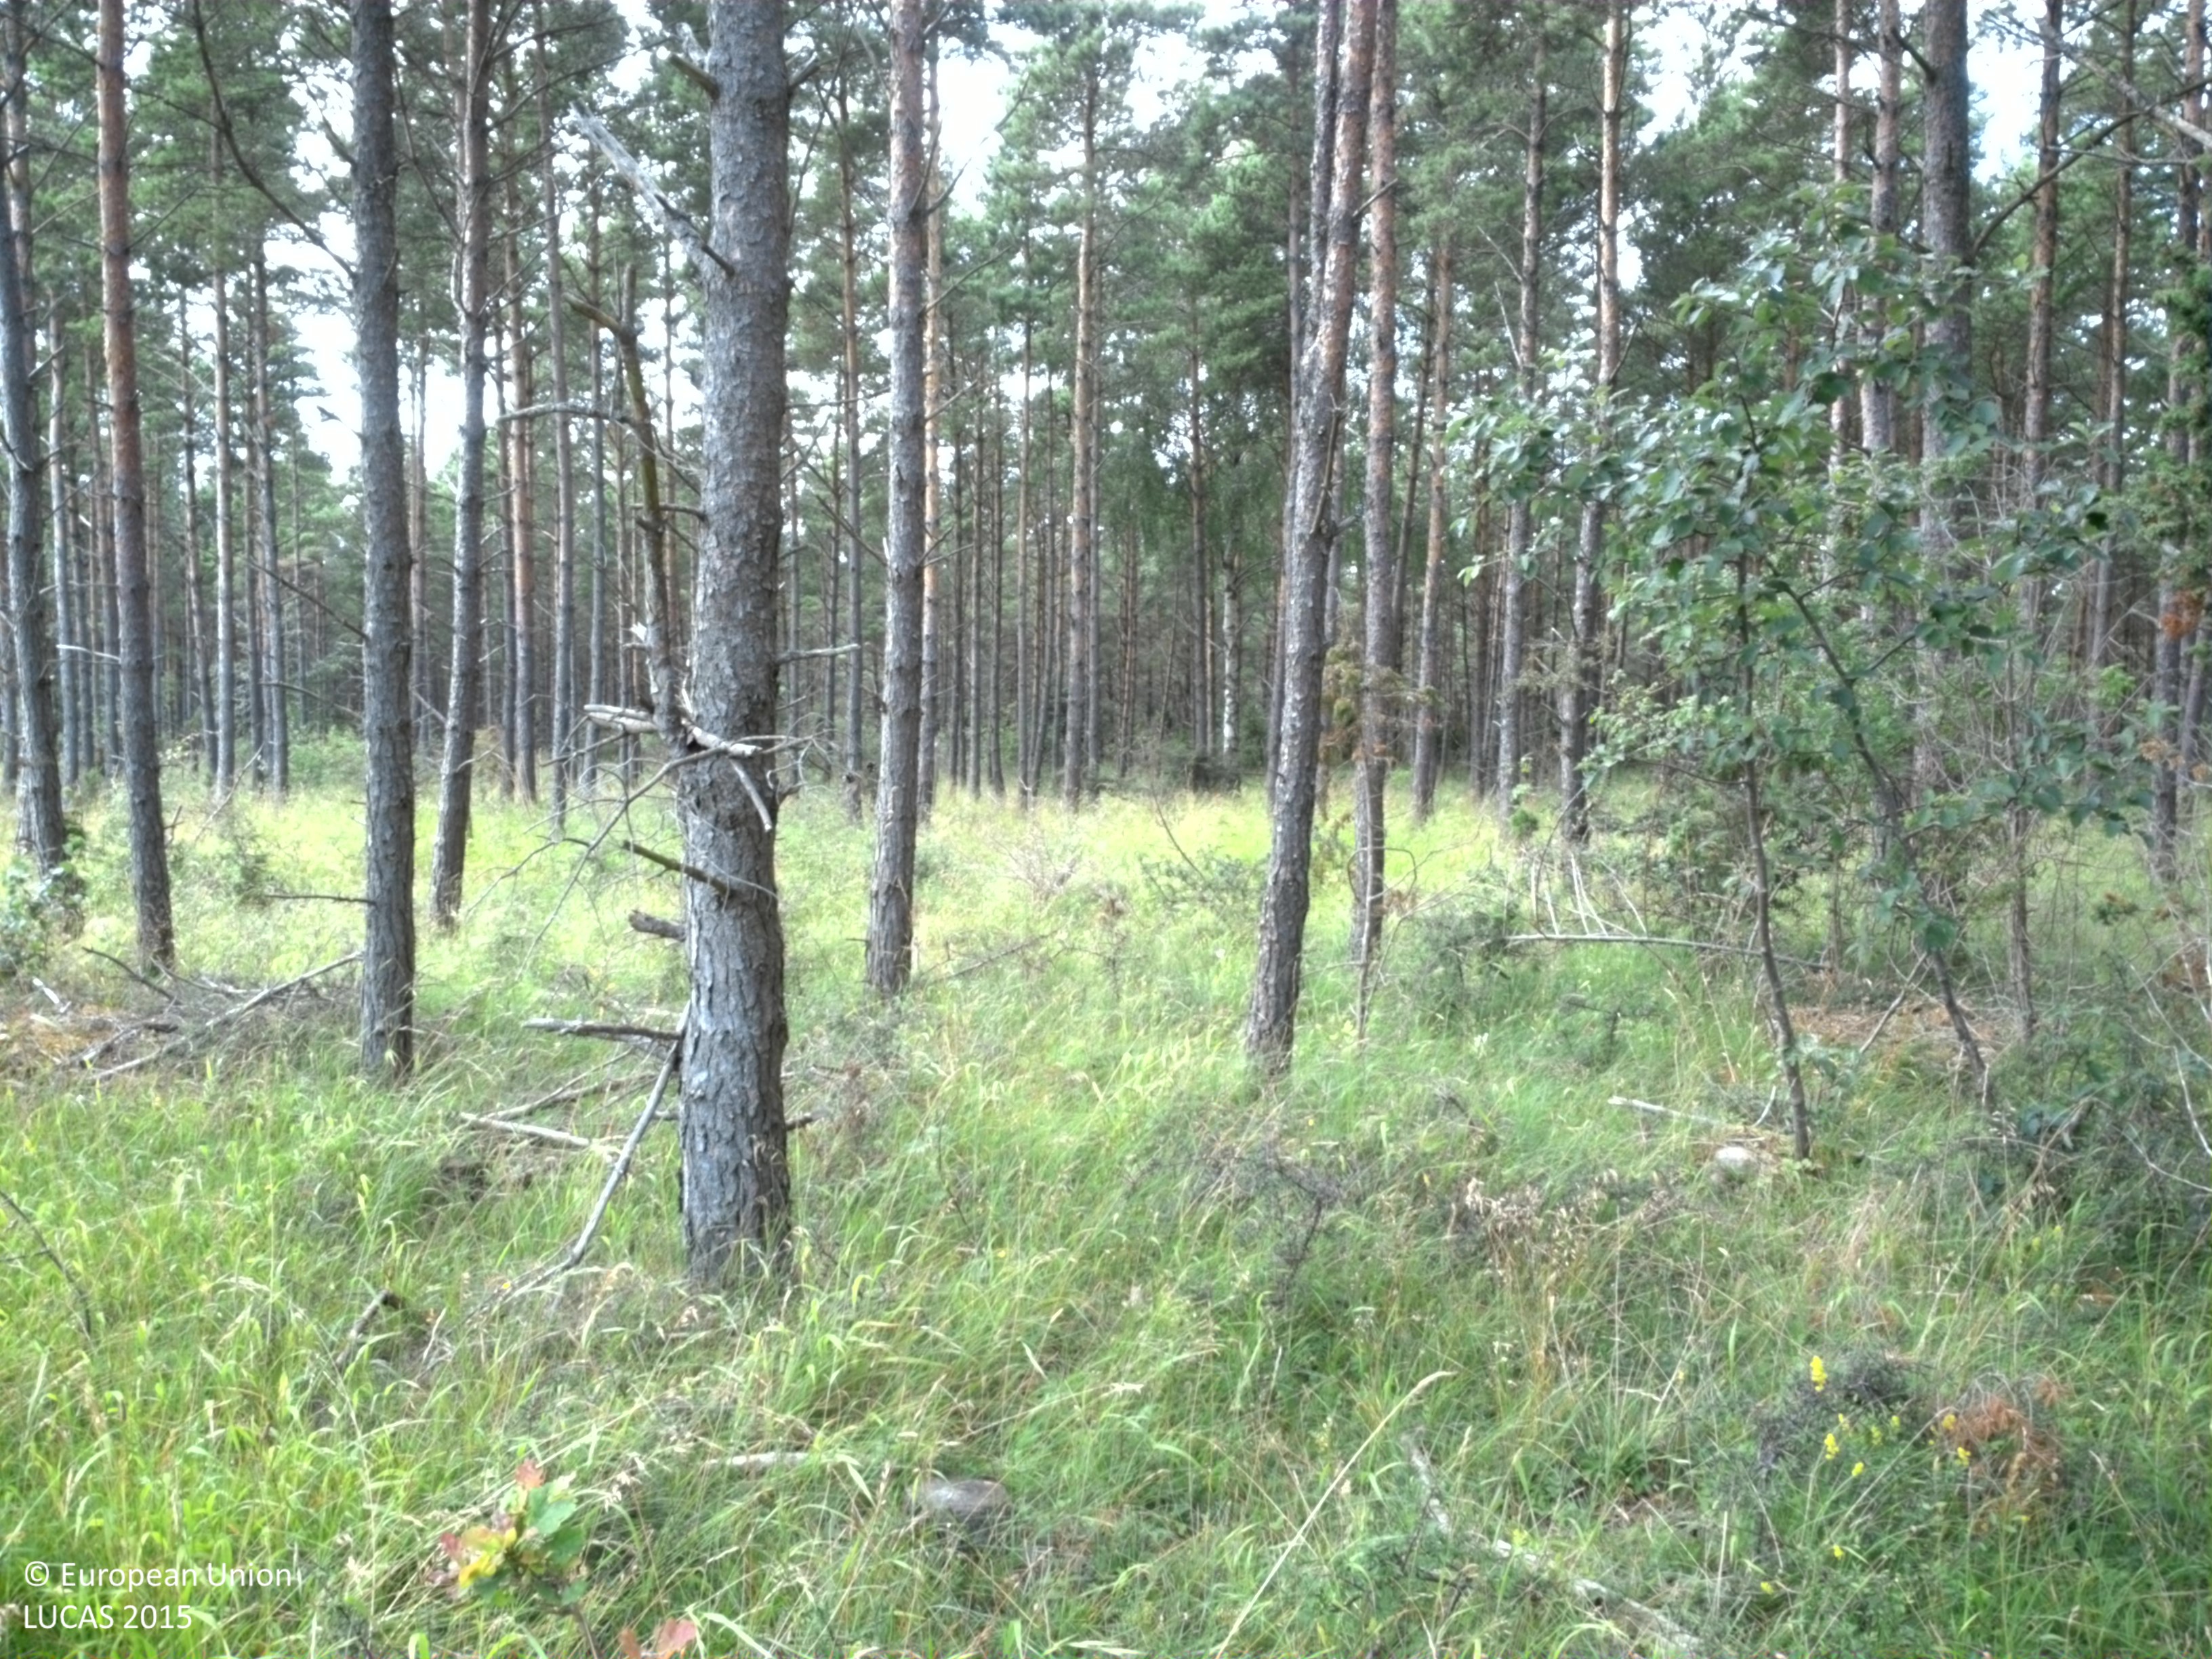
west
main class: Woodland
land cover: Pine dominated coniferous woodland
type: hemiboreal forest and nemoral coniferous forest and mixed broadleaved-coniferous forest
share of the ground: > 75 %
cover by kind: coniferous forest trees 75 %, herbaceous plants 15 %, shrubs 10 %
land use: Forestry
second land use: Agriculture (excluding fallow land and kitchen gardens)
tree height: > 5 m
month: July
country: SE
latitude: 57.1553
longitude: 18.1911
